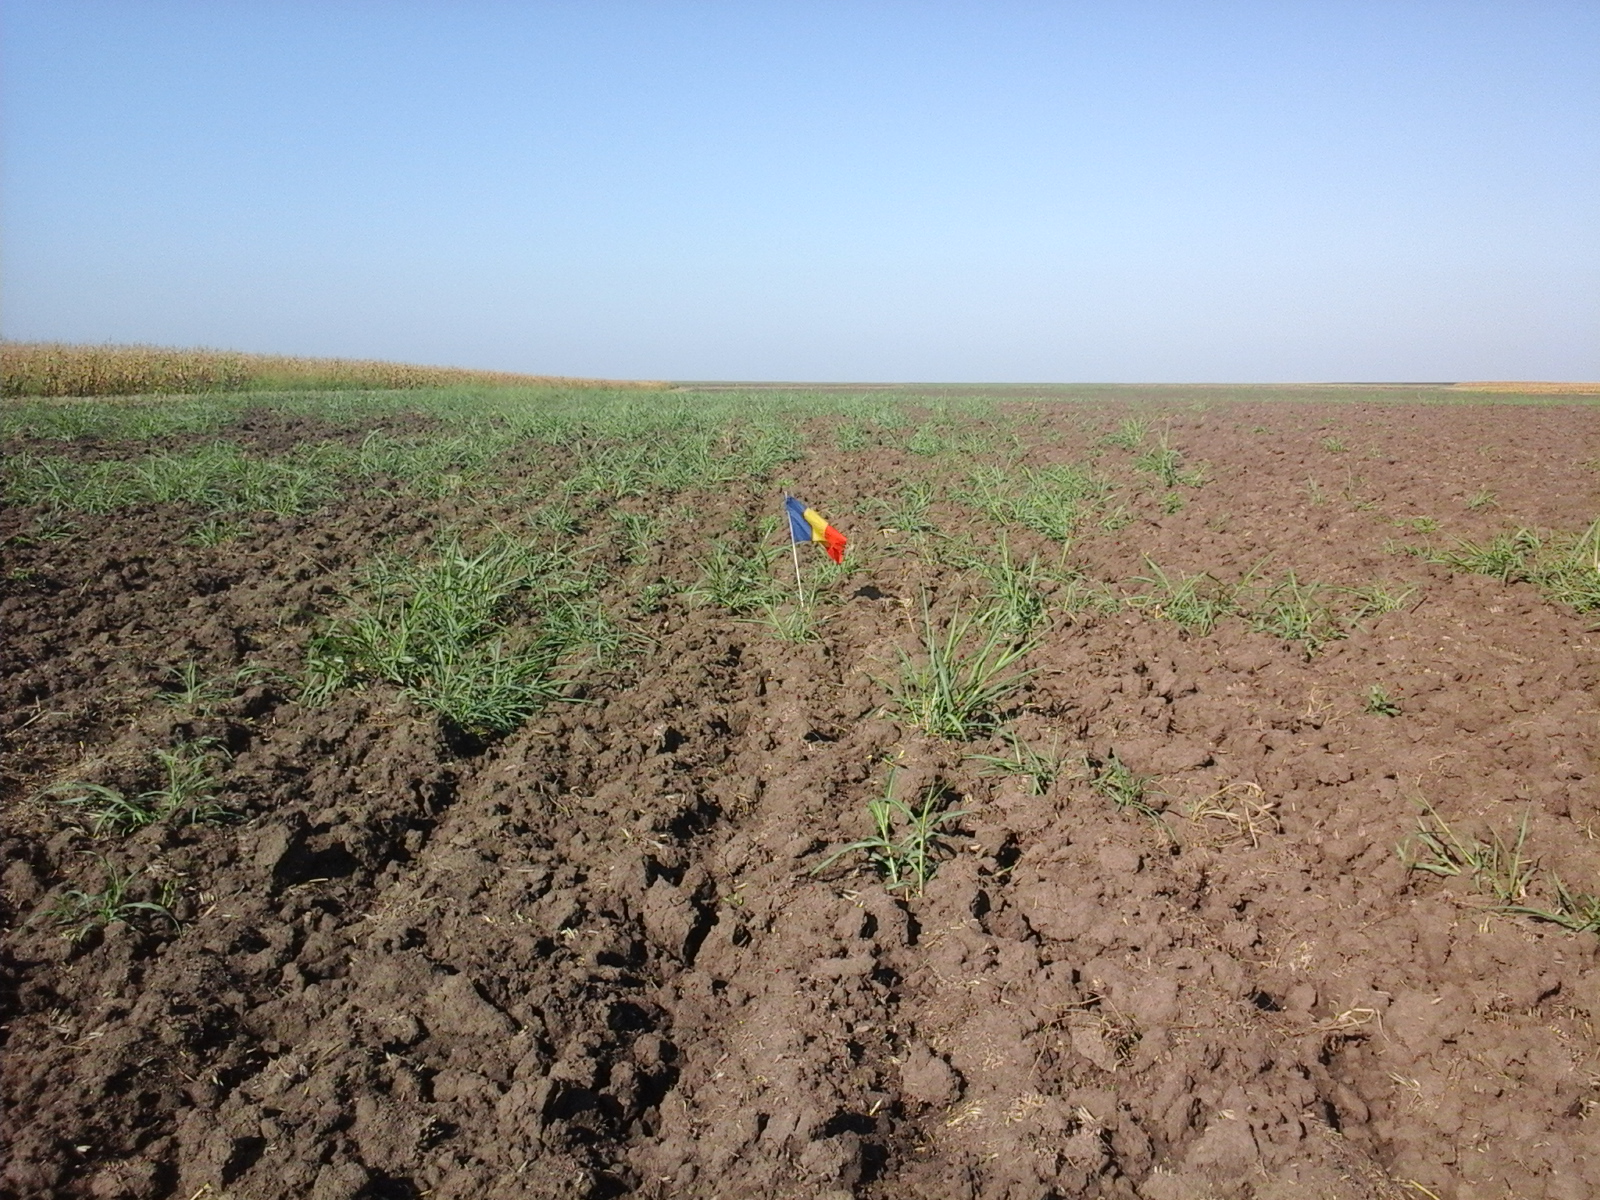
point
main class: Cropland
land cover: Common wheat
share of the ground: 10 - 25 %
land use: Agriculture (excluding fallow land and kitchen gardens)
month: August
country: RO
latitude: 46.0614
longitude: 21.1091
